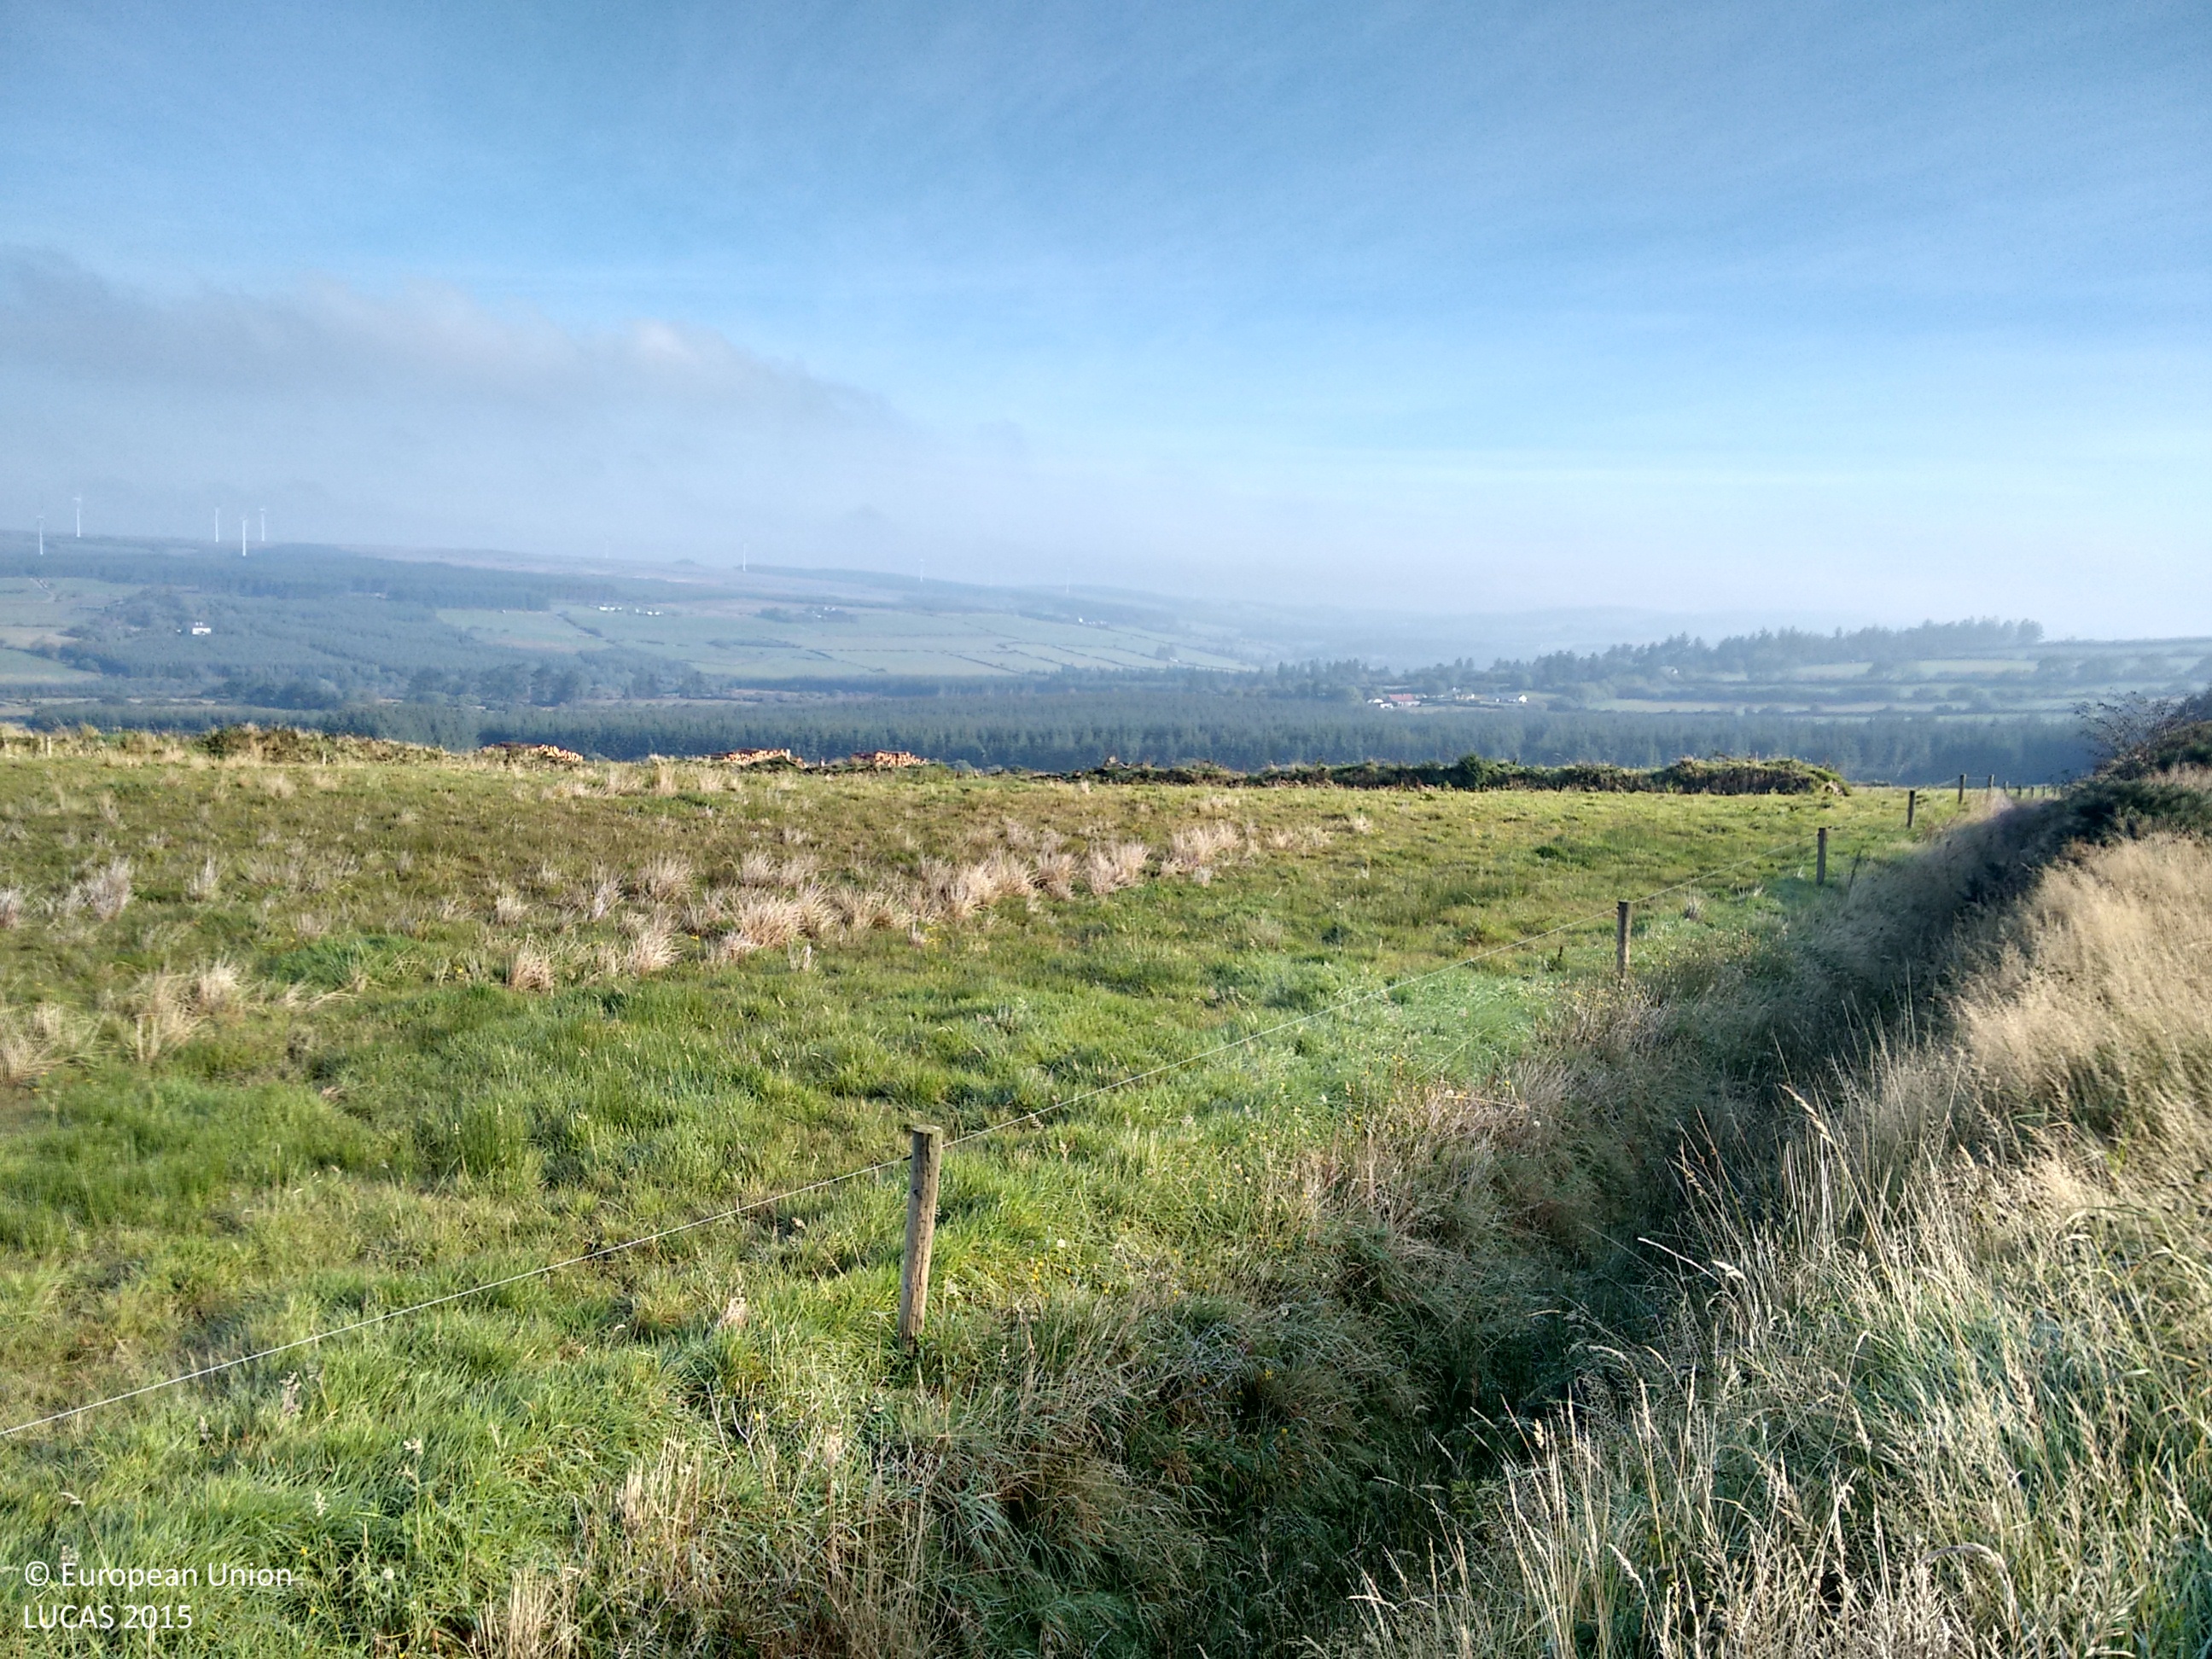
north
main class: Grassland
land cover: Grassland without tree/shrub cover
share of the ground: > 75 %
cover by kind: herbaceous plants 95 %, shrubs 5 %
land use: Agriculture (excluding fallow land and kitchen gardens)
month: September
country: IE
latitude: 52.4120
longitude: -9.2311
